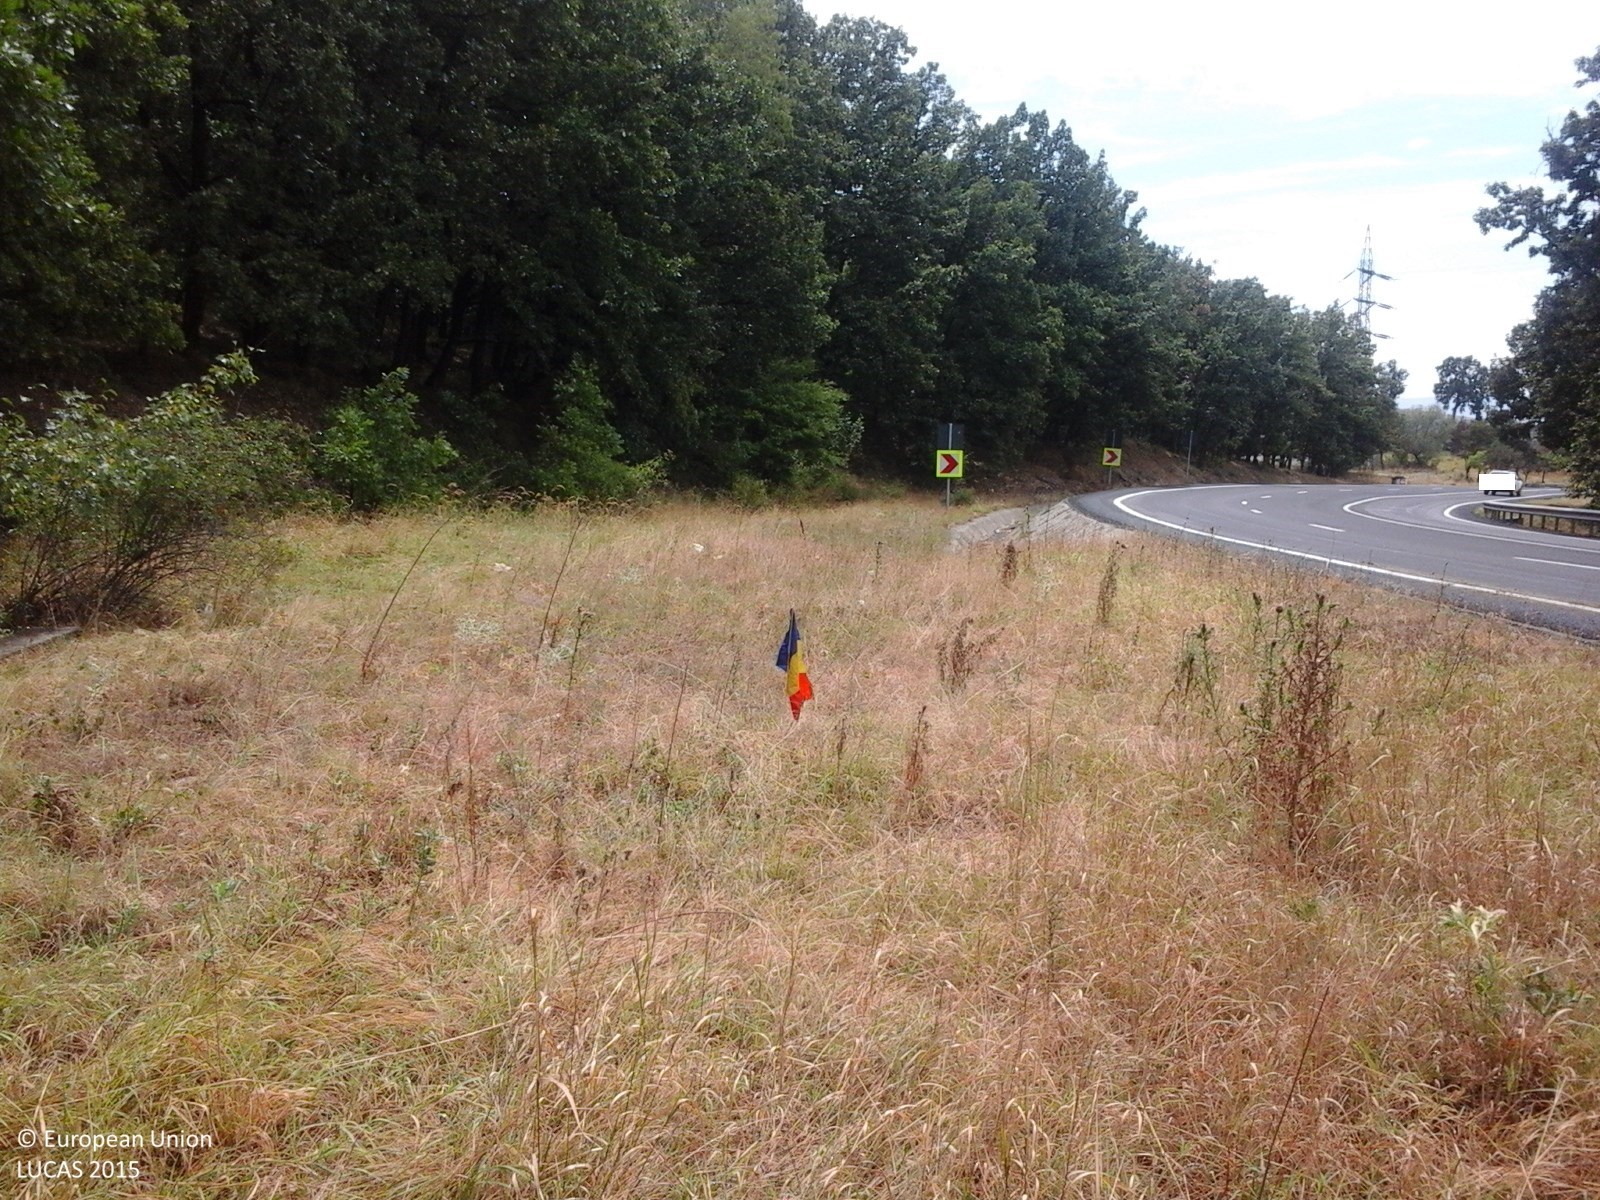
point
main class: Grassland
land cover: Grassland without tree/shrub cover
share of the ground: > 75 %
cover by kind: herbaceous plants 100 %
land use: Semi-natural and natural areas not in use
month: August
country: RO
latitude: 44.6142
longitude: 22.7834
